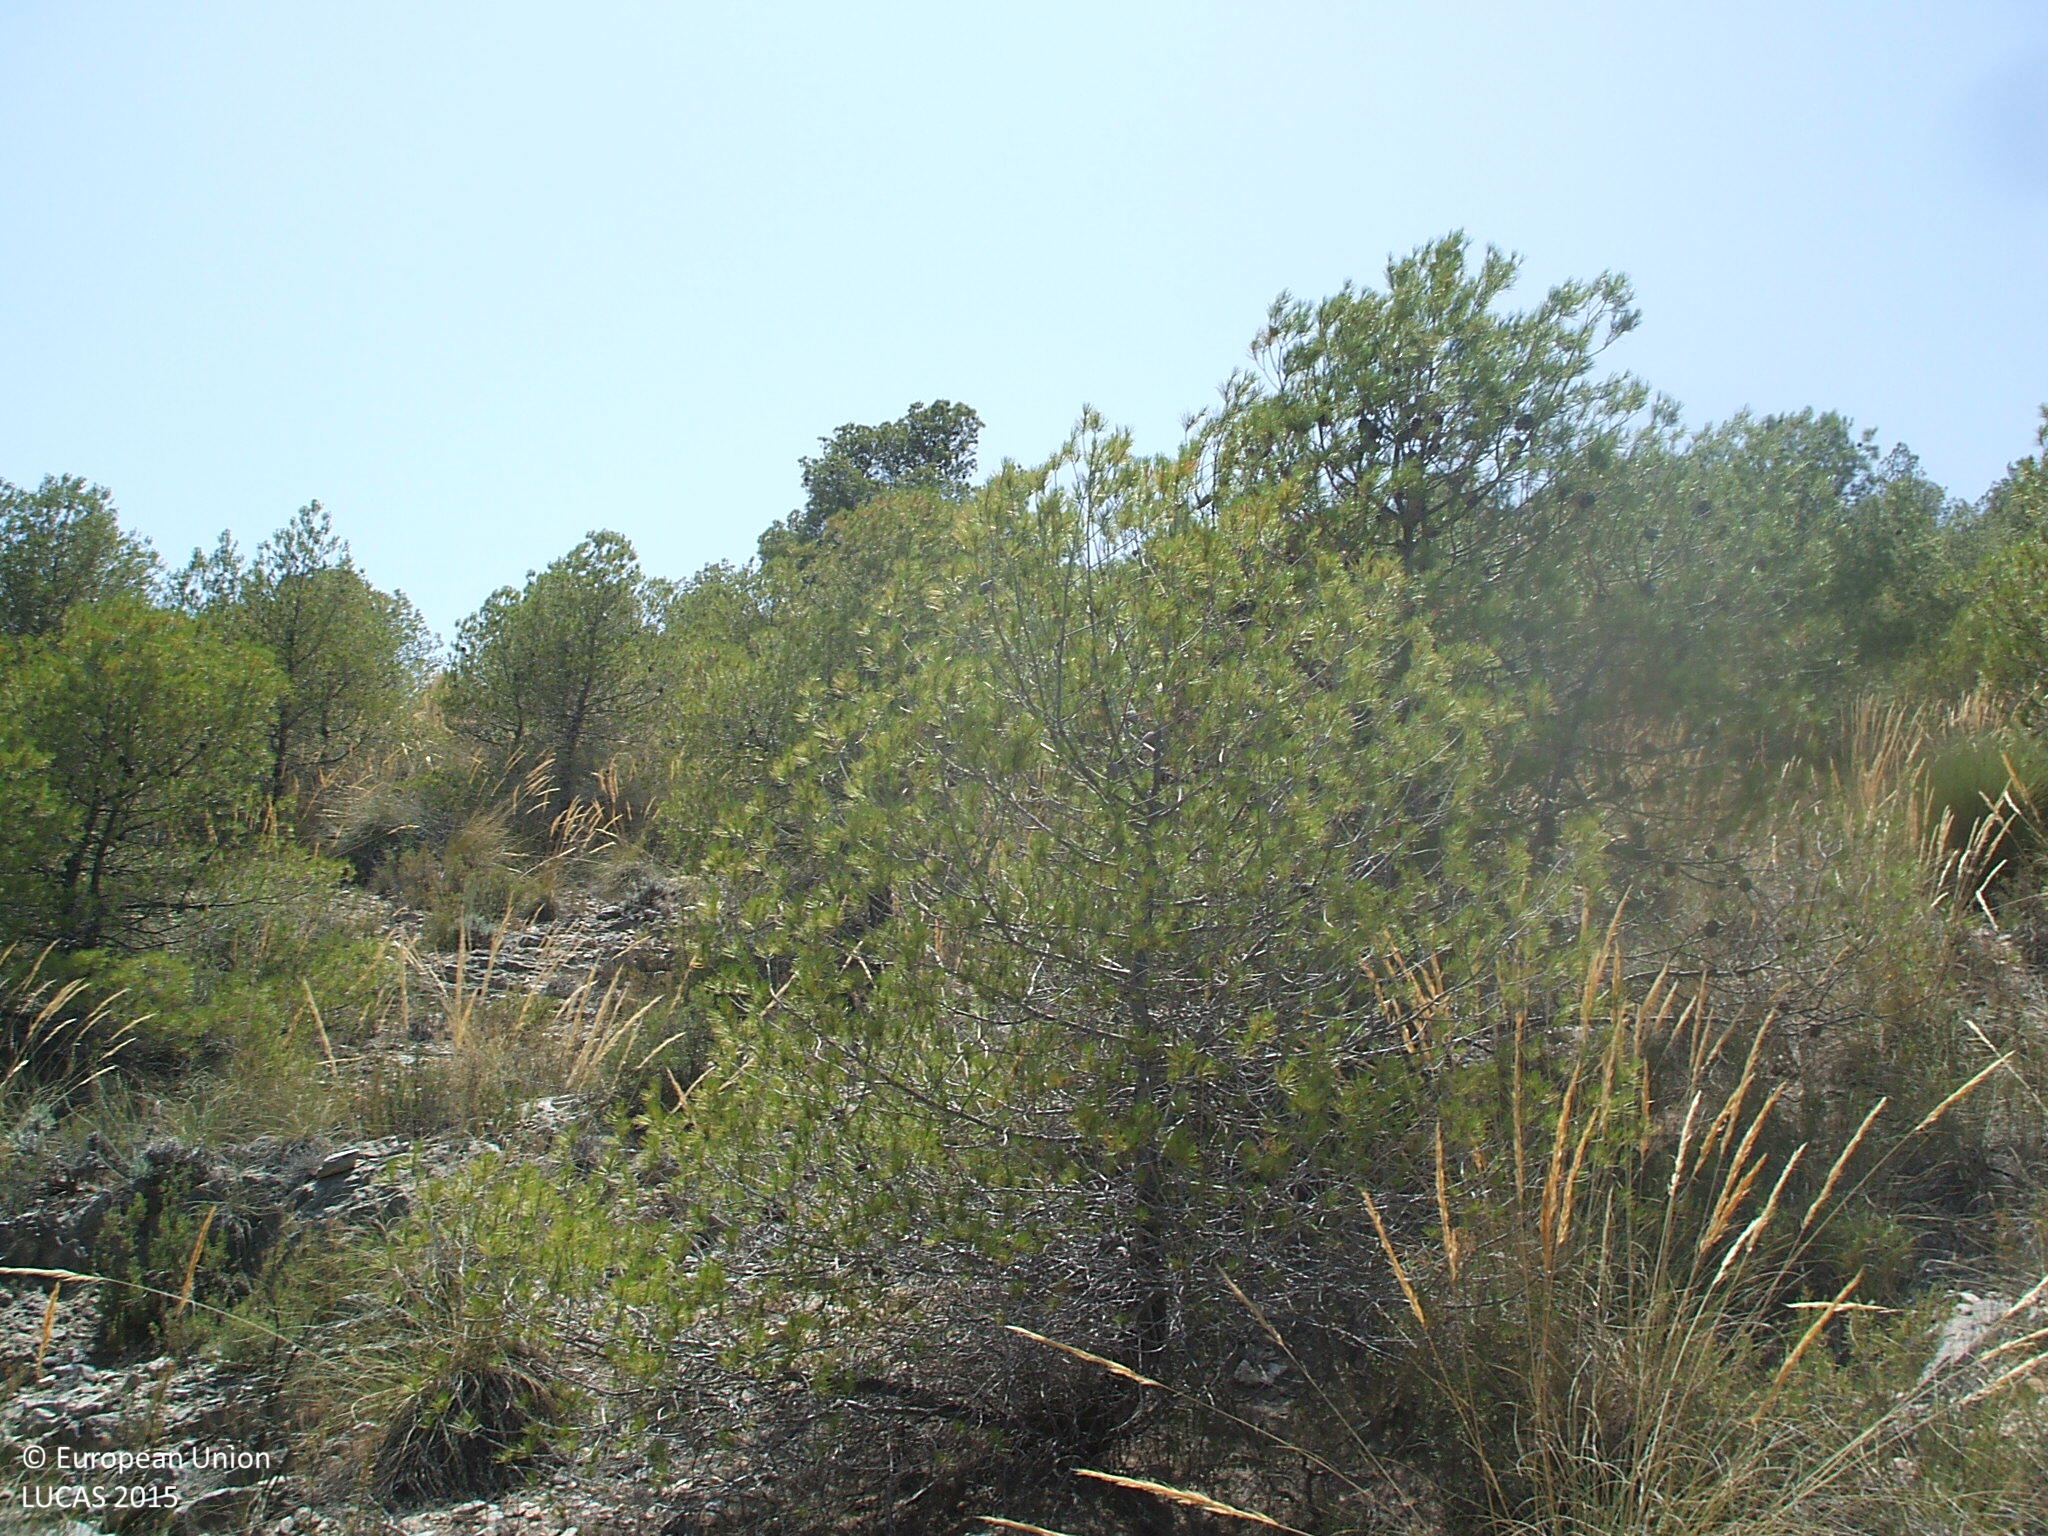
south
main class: Woodland
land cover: Pine dominated coniferous woodland
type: coniferous forest of the mediterranean region
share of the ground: 50 - 75 %
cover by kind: coniferous forest trees 70 %, consolidated bare surface 30 %
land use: Forestry
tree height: > 5 m
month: July
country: ES
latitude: 37.4091
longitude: -2.3995
